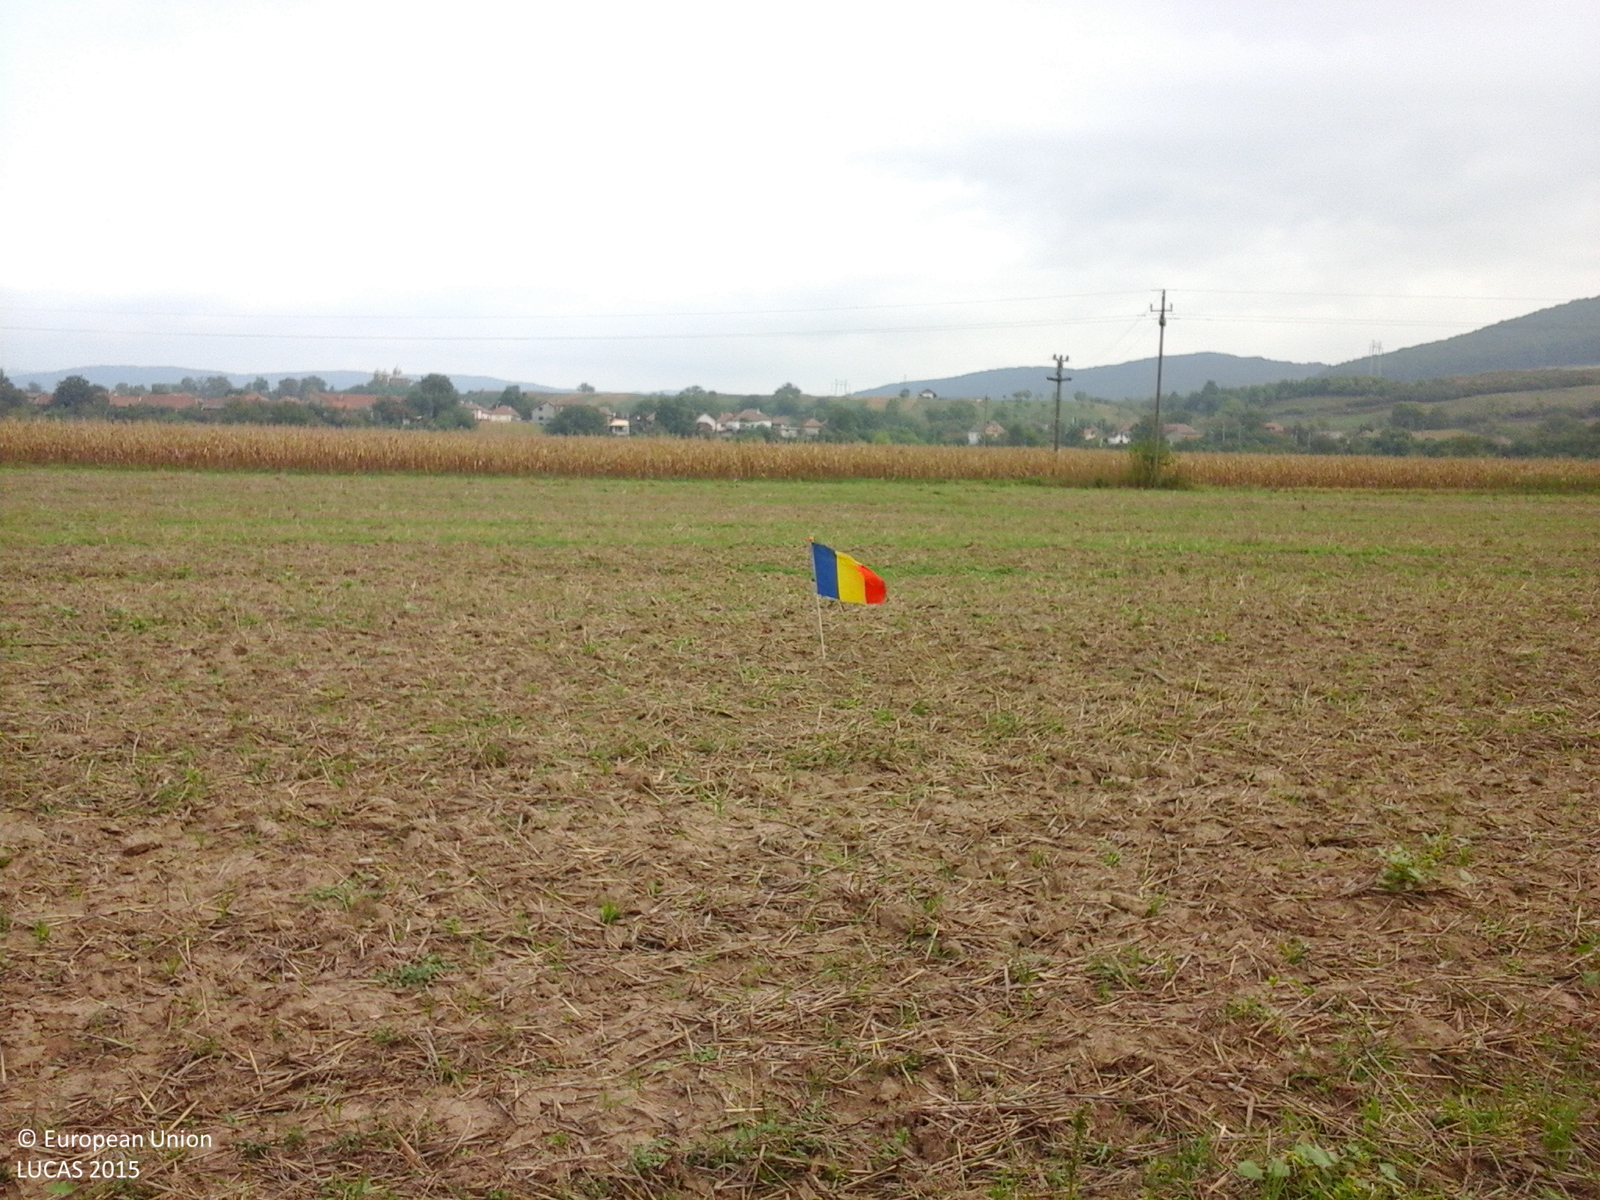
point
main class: Cropland
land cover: Common wheat
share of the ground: 10 - 25 %
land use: Agriculture (excluding fallow land and kitchen gardens)
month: September
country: RO
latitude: 45.9095
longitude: 22.7759
